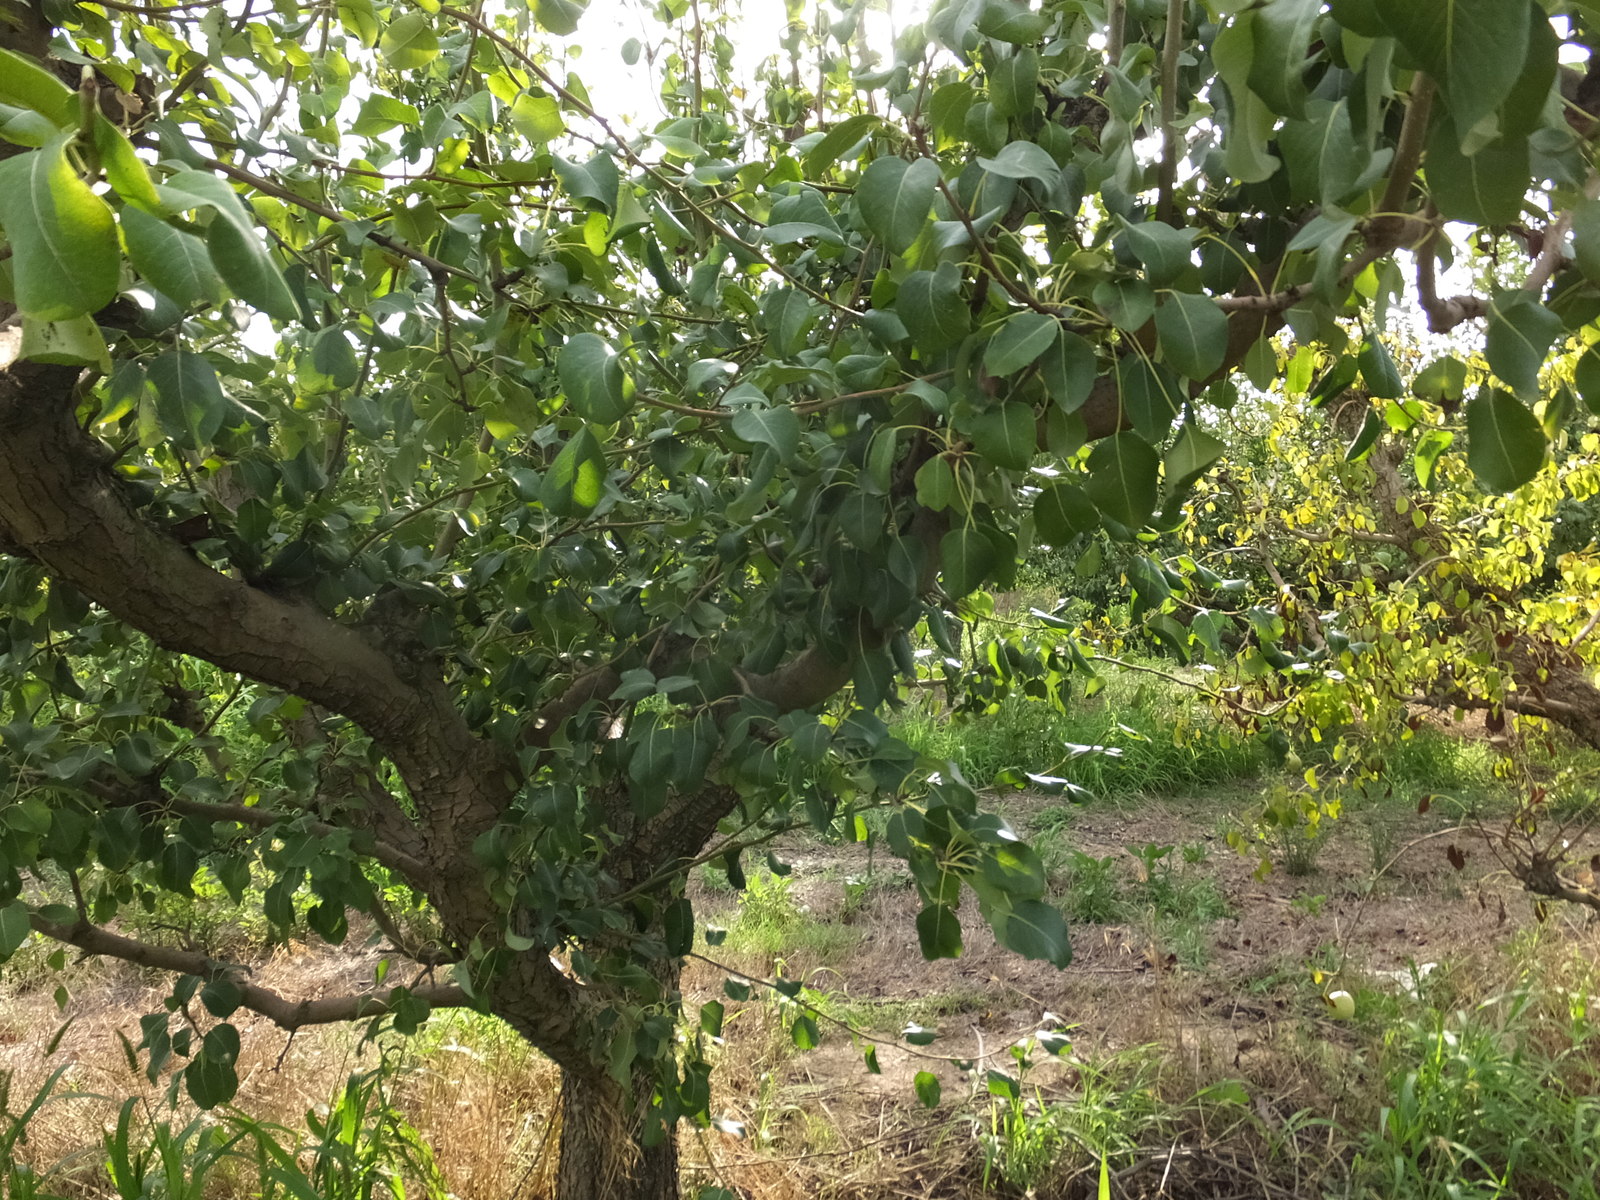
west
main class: Cropland
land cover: Pear fruit
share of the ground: > 75 %
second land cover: Spontaneously vegetated surfaces
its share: 10 - 25 %
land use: Agriculture (excluding fallow land and kitchen gardens)
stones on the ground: < 10 %
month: August
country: ES
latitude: 41.5278
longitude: 0.4358
